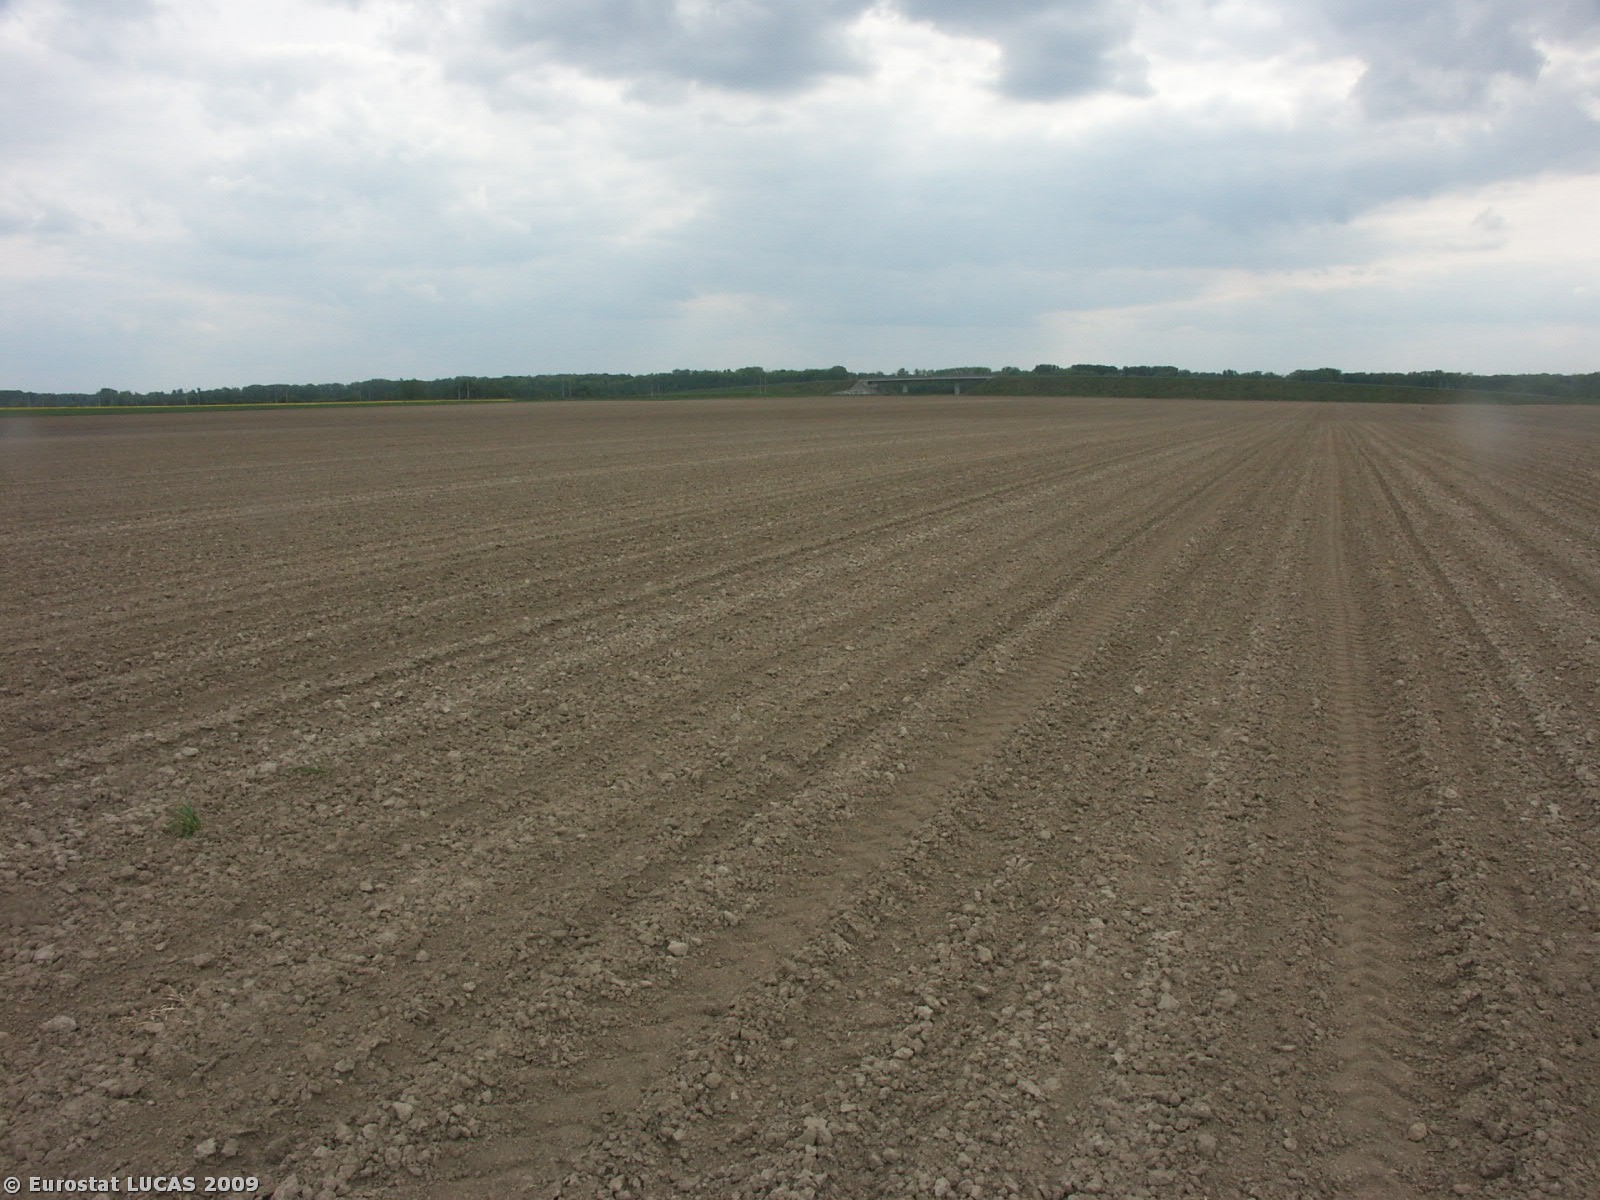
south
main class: Cropland
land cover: Maize
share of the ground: < 10 %
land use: Agriculture (excluding fallow land and kitchen gardens)
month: May
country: CZ
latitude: 49.6854
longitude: 17.2042
